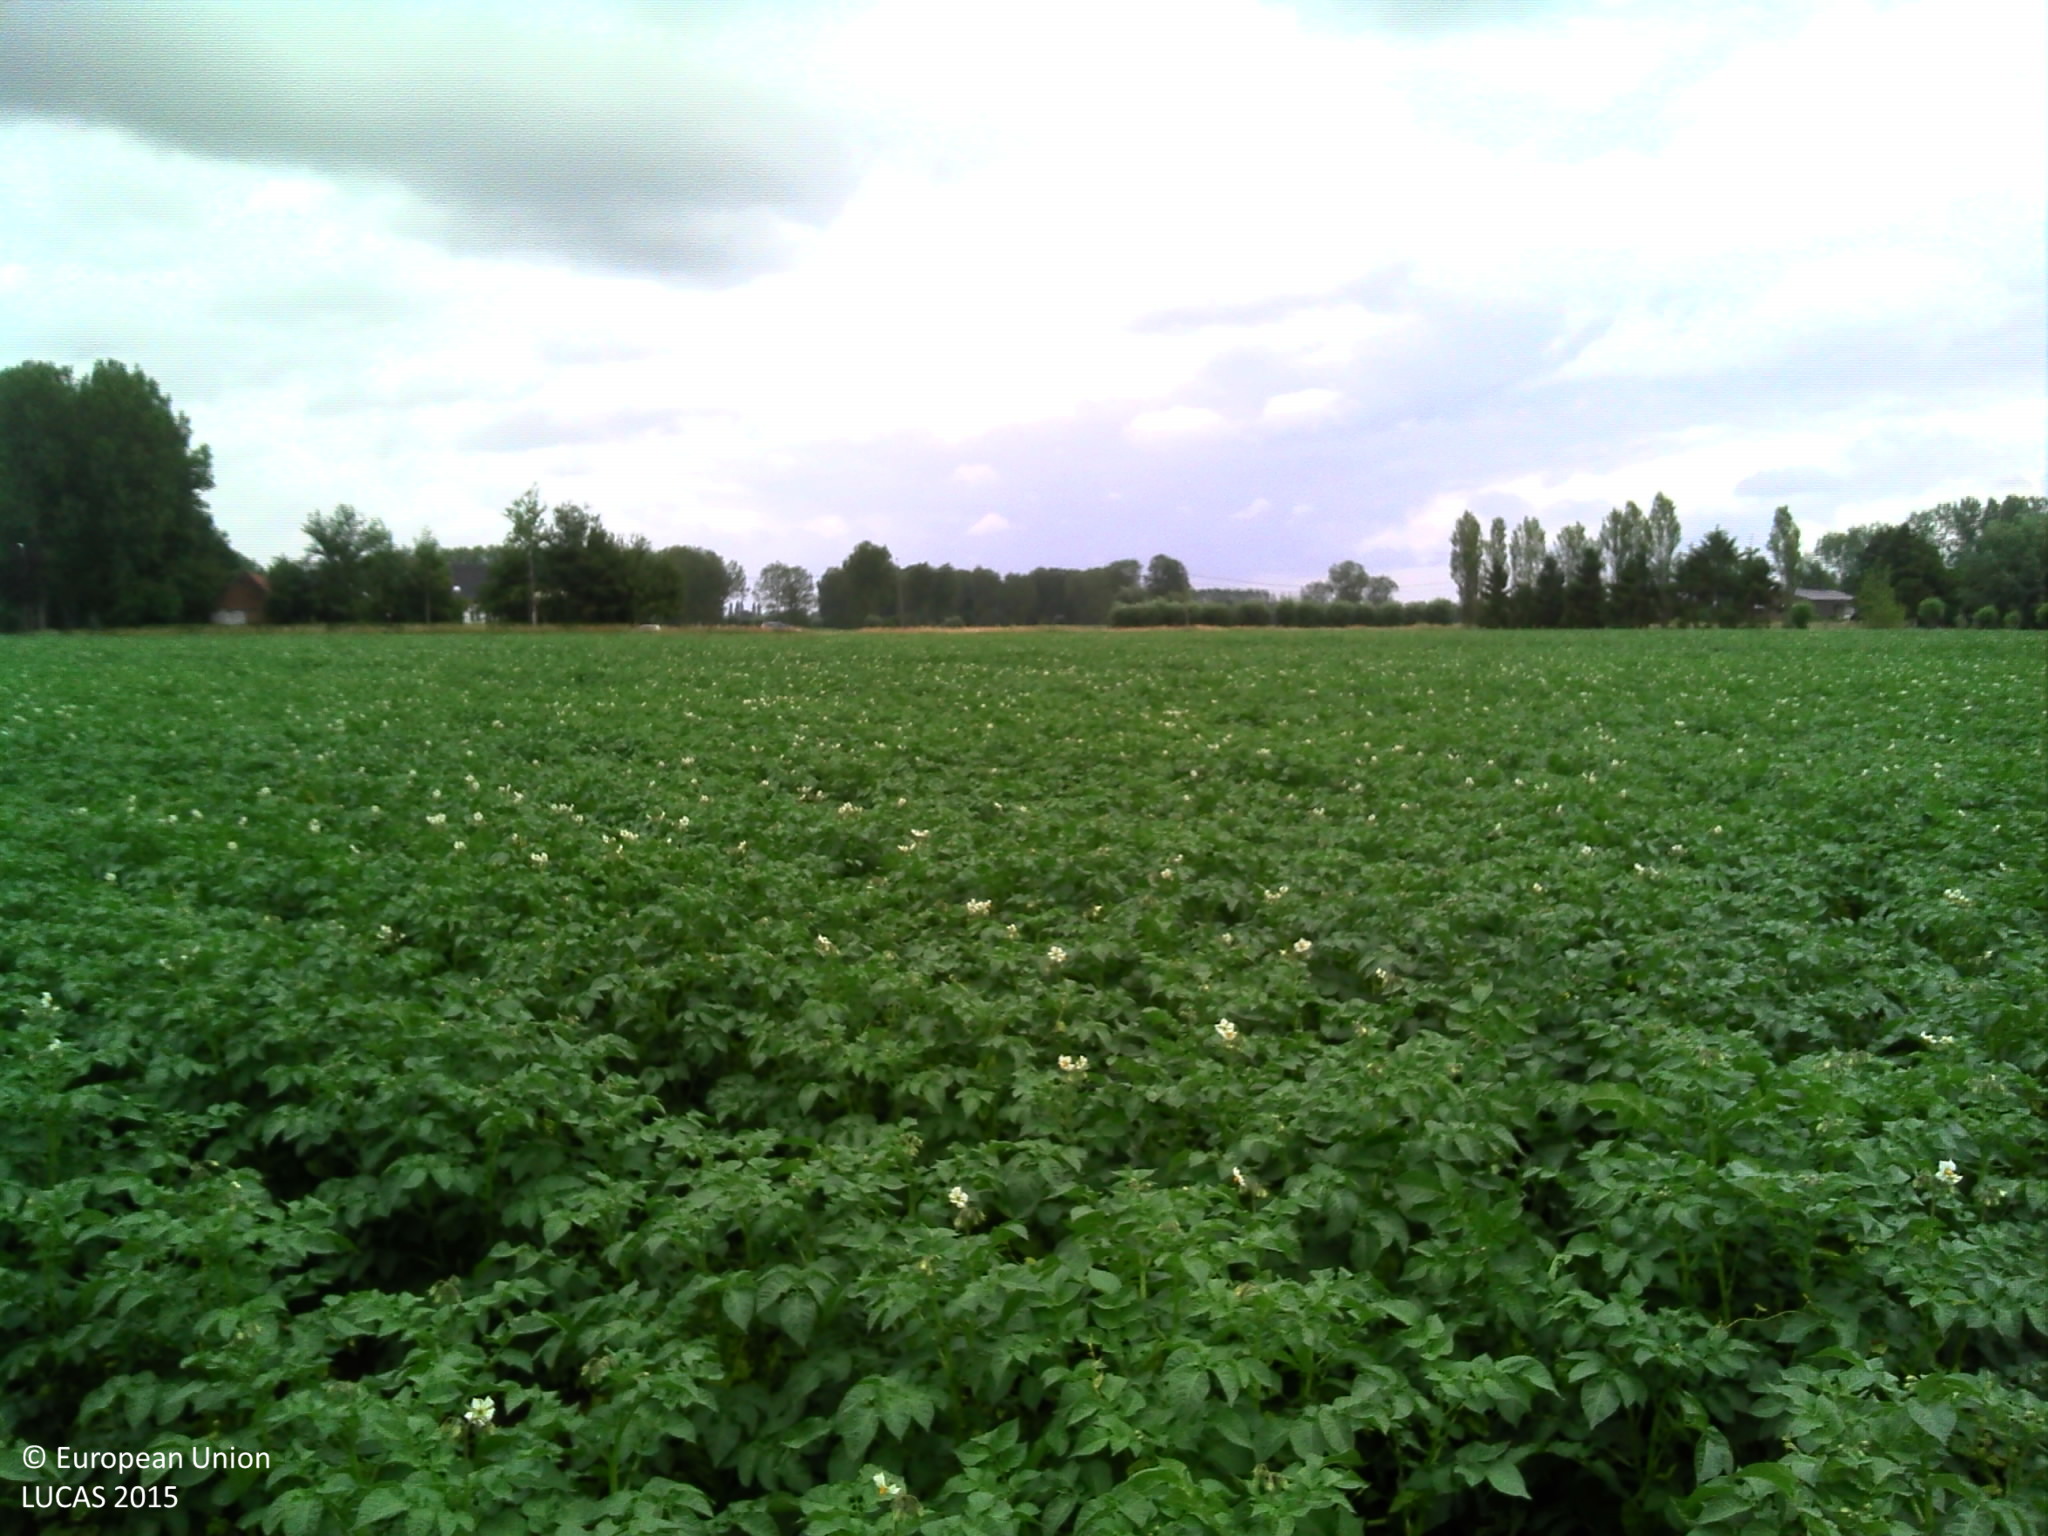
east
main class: Cropland
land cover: Potatoes
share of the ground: > 75 %
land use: Agriculture (excluding fallow land and kitchen gardens)
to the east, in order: Potatoes; Ditches and canals; Potatoes; Ditches and canals; Grass margins; Paved roads, cycling and walking lanes; Grass margins; Electric lines; Grass margins; Ditches and canals; Maize
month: June
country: BE
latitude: 51.1623
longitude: 4.0025
